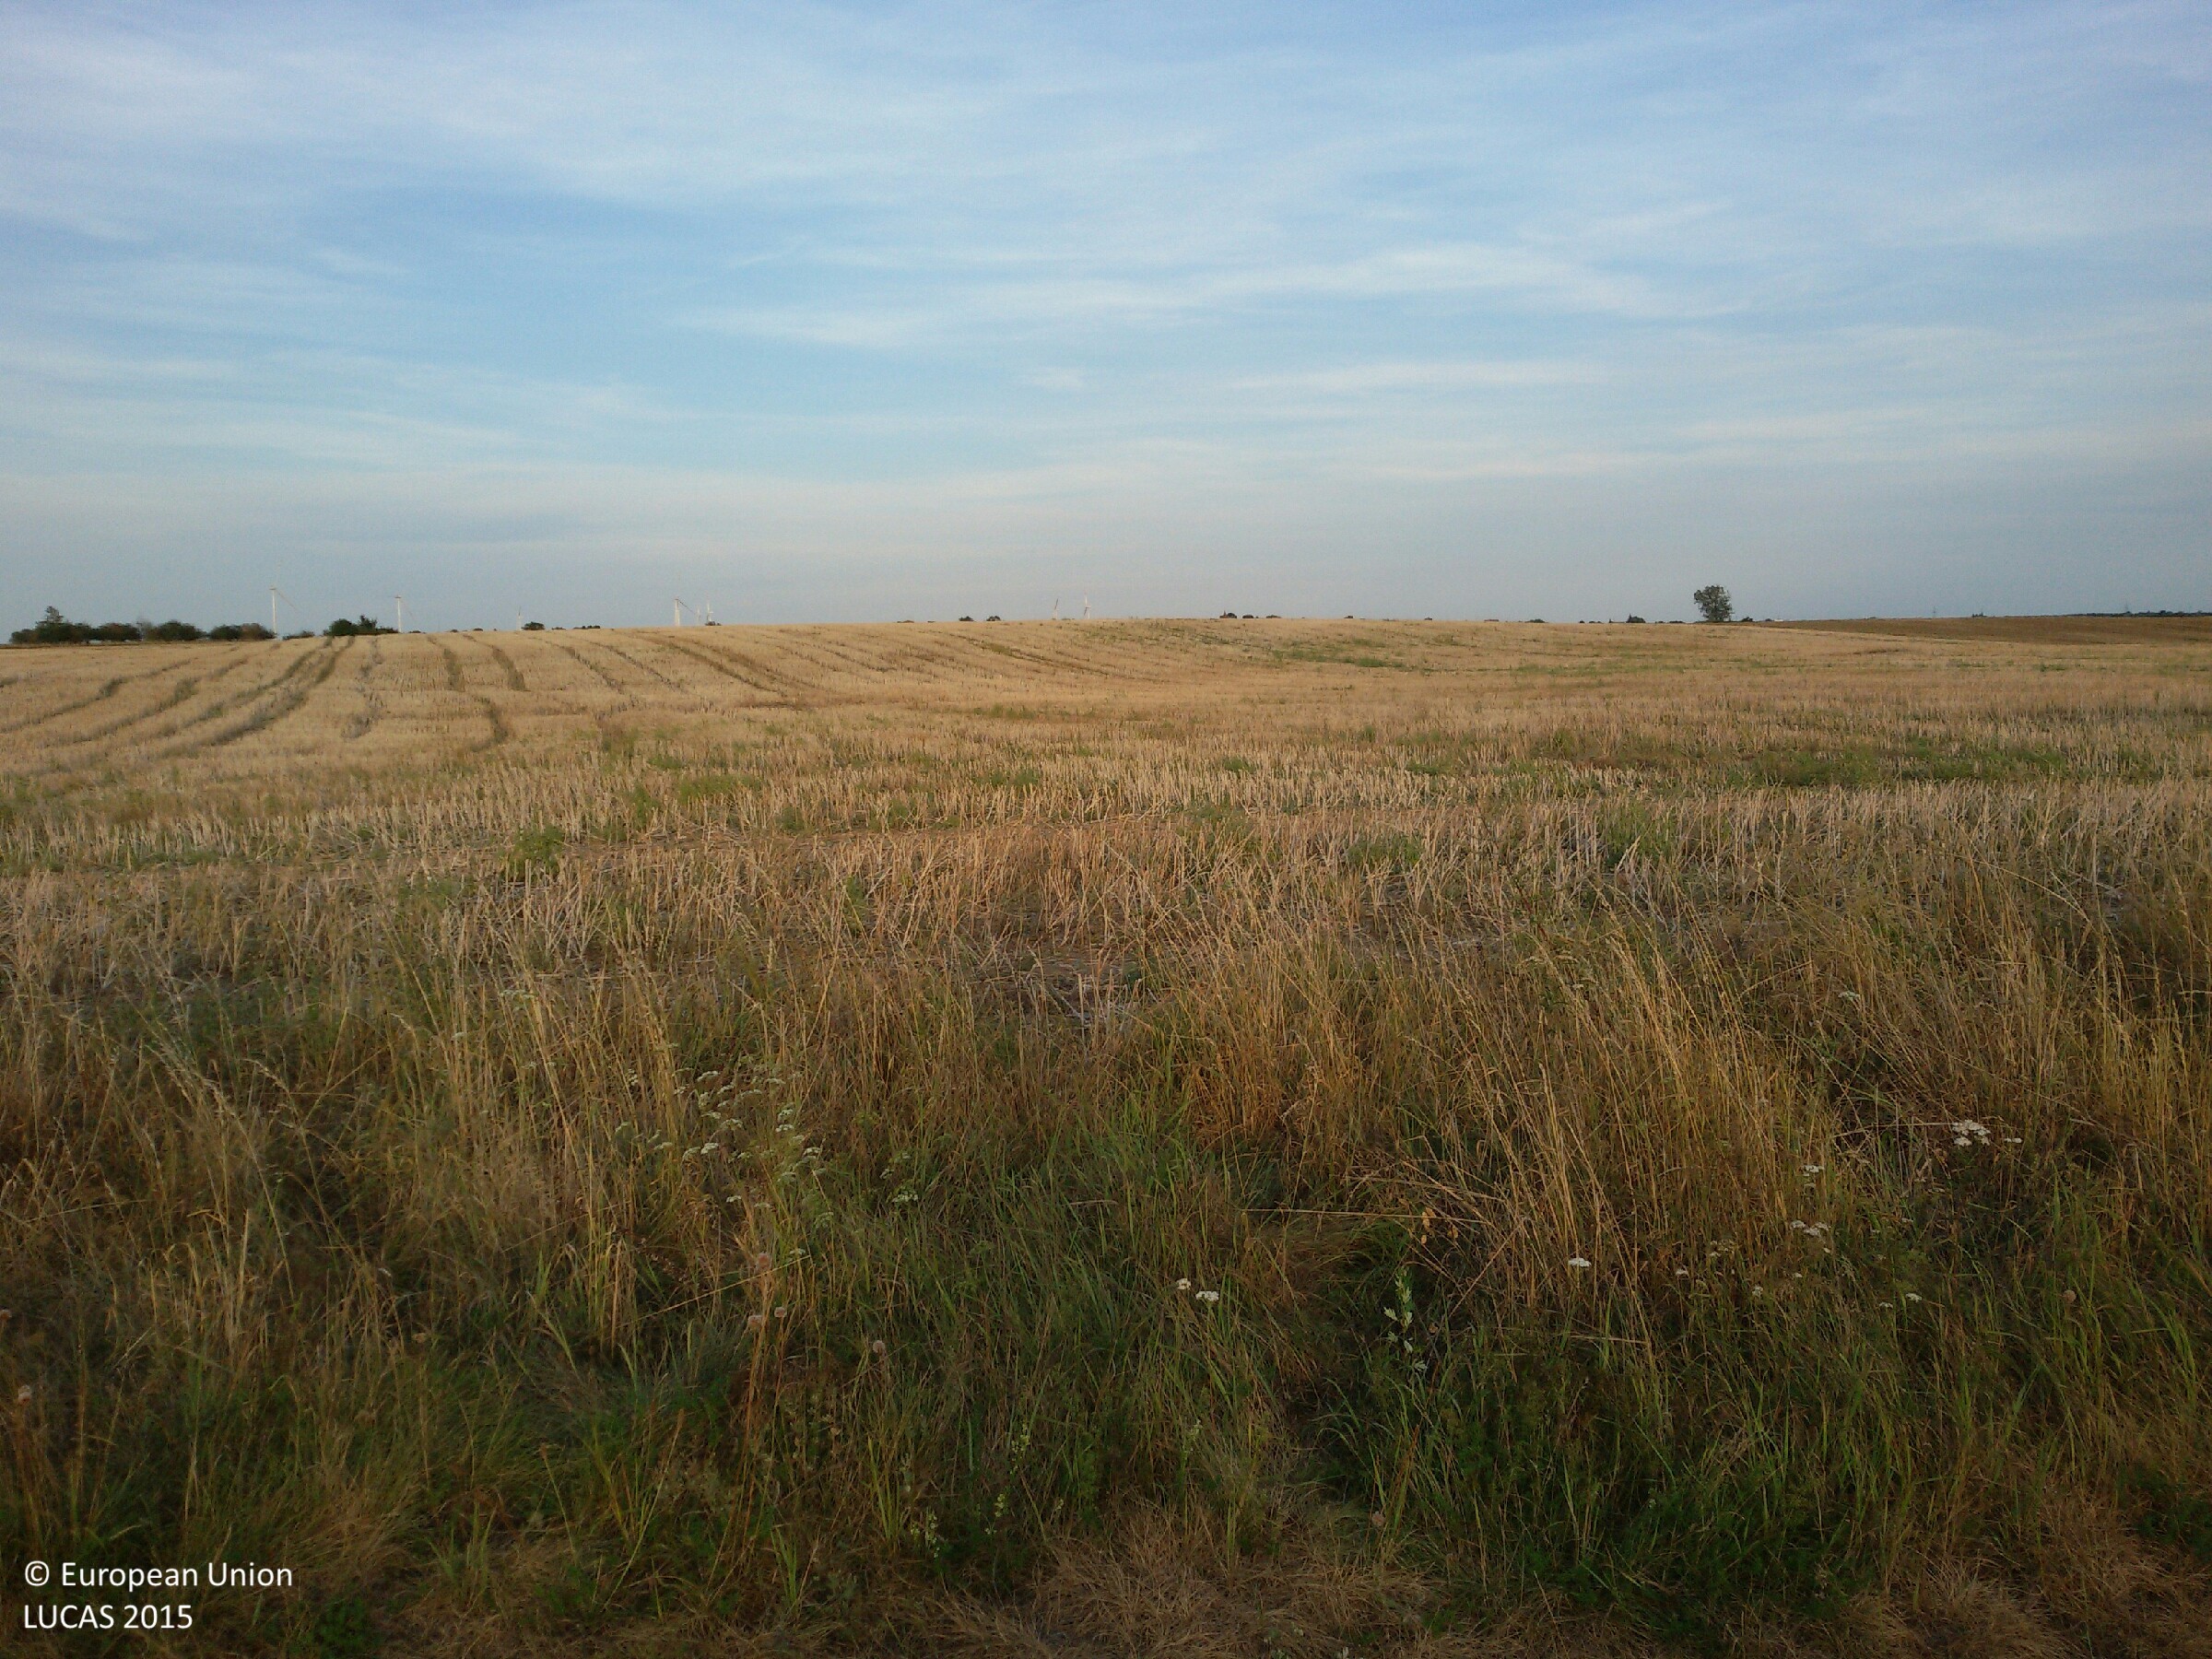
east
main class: Cropland
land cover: Maize
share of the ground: > 75 %
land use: Agriculture (excluding fallow land and kitchen gardens)
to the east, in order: Maize; Grassland without tree/shrub cover; Tracks; Grassland without tree/shrub cover; Rape and turnip rape
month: August
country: PL
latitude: 52.3727
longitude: 14.7464
